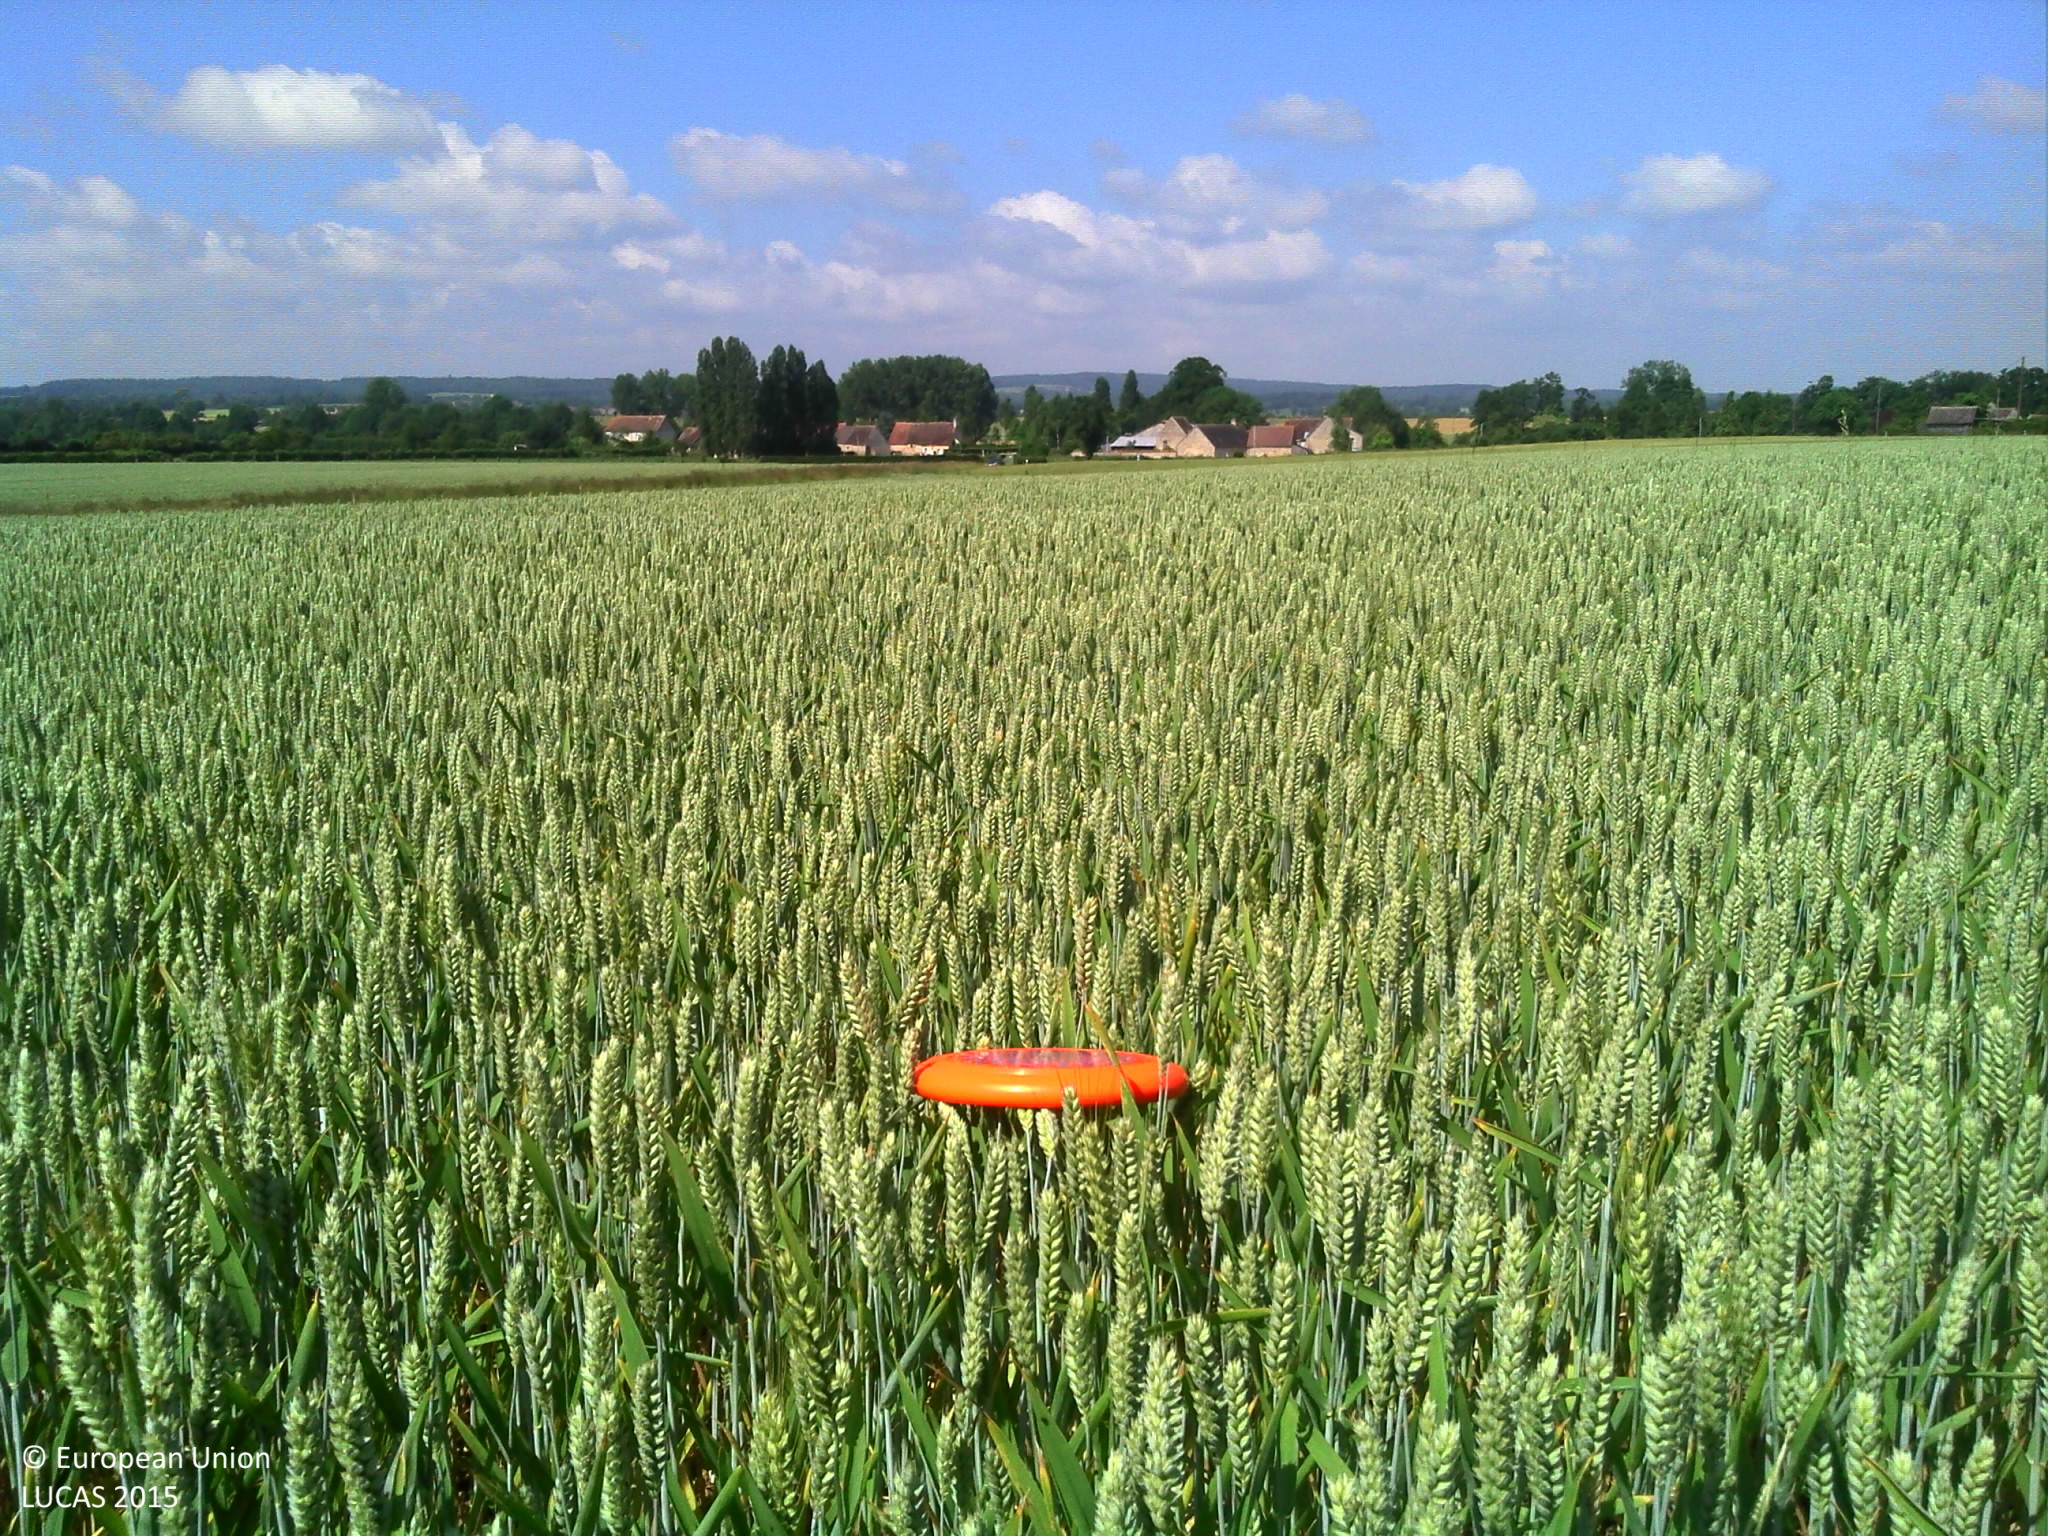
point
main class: Cropland
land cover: Common wheat
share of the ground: > 75 %
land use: Agriculture (excluding fallow land and kitchen gardens)
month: June
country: FR
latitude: 48.6294
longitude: 0.1070
